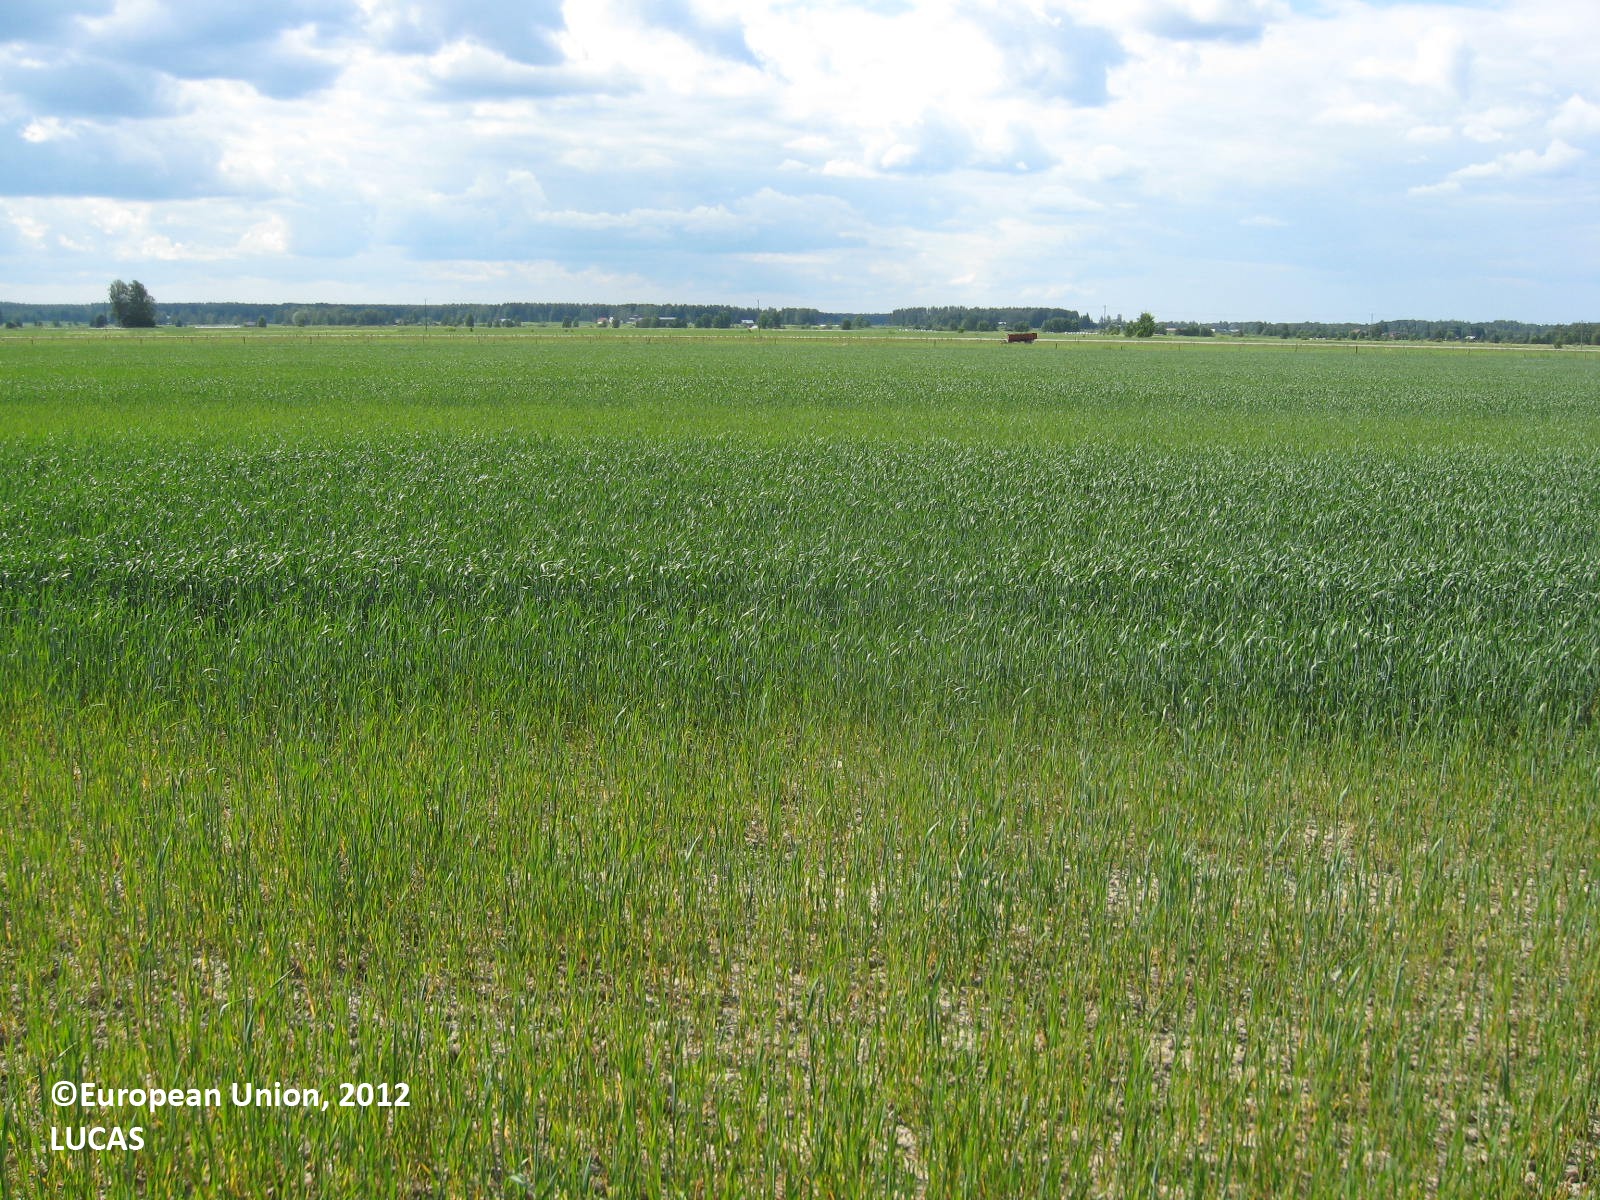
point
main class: Cropland
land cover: Common wheat
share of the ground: > 75 %
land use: Agriculture (excluding fallow land and kitchen gardens)
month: July
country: FI
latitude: 62.5804
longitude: 22.5326
